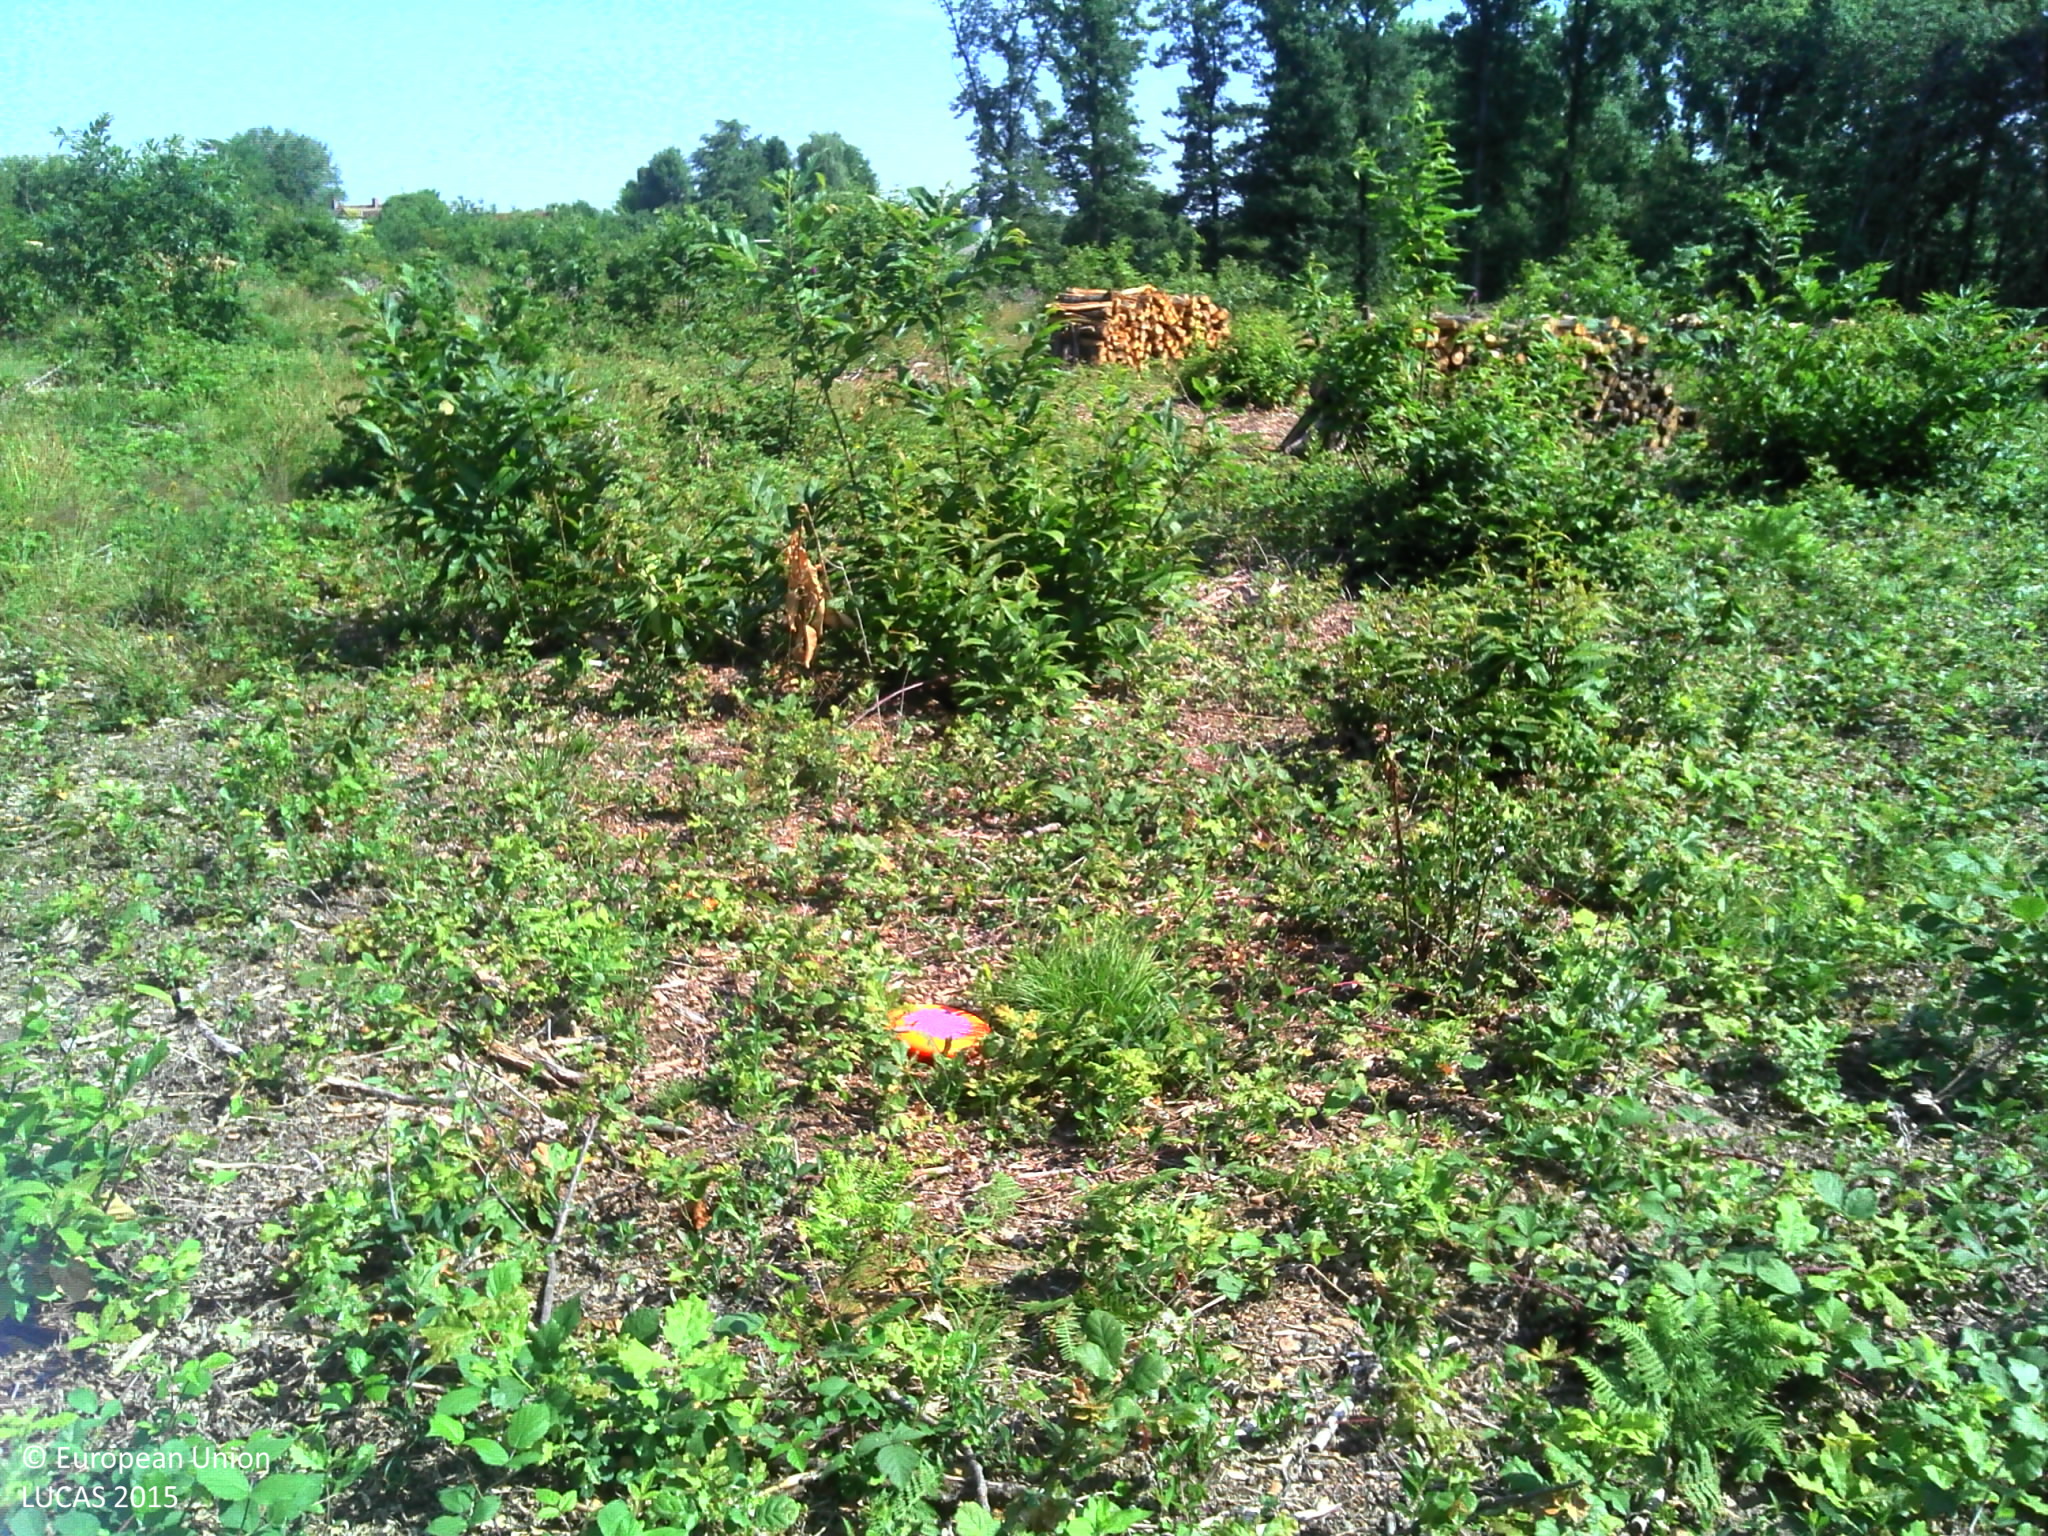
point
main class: Grassland
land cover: Grassland with sparse tree/shrub cover
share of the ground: 50 - 75 %
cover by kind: herbaceous plants 85 %, shrubs 10 %, broadleaved forest trees 5 %
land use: Forestry
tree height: < 5 m
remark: Clear cut
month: June
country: FR
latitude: 47.7553
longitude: 0.0621
